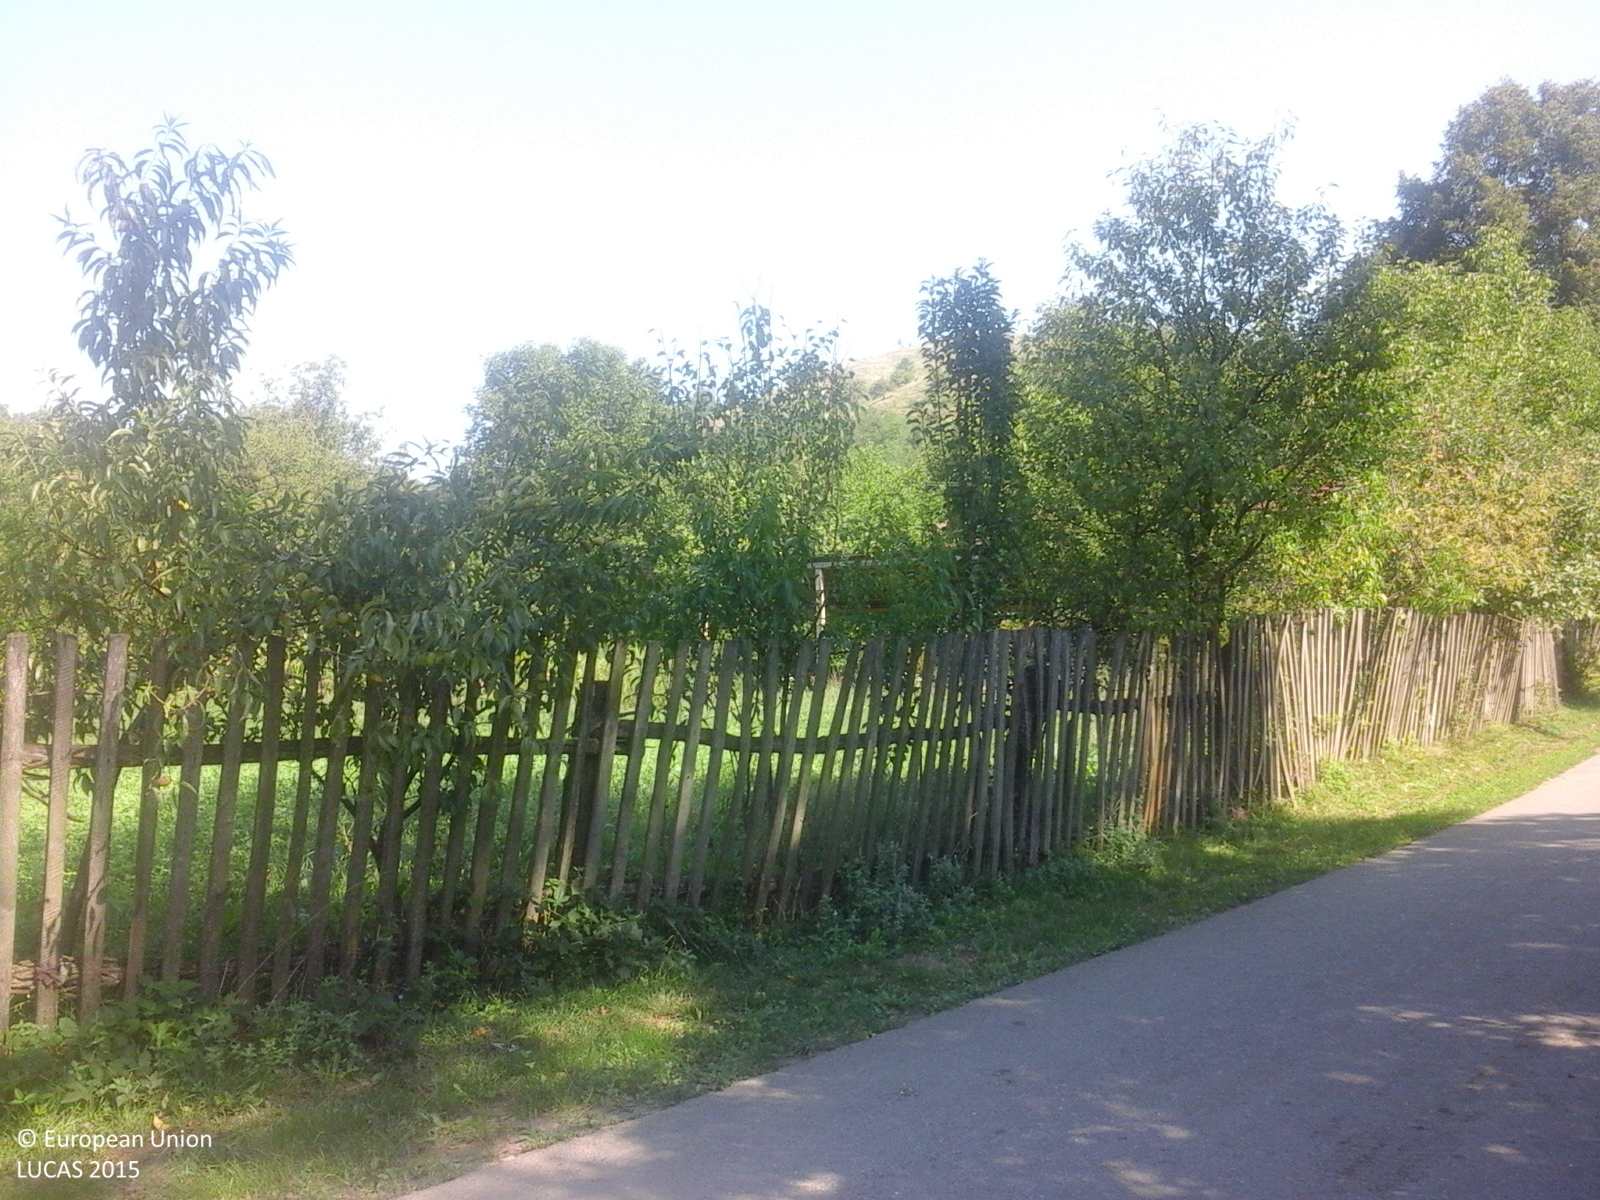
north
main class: Cropland
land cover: Lucerne
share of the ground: > 75 %
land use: Agriculture (excluding fallow land and kitchen gardens)
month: August
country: RO
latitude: 46.1176
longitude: 22.4054
